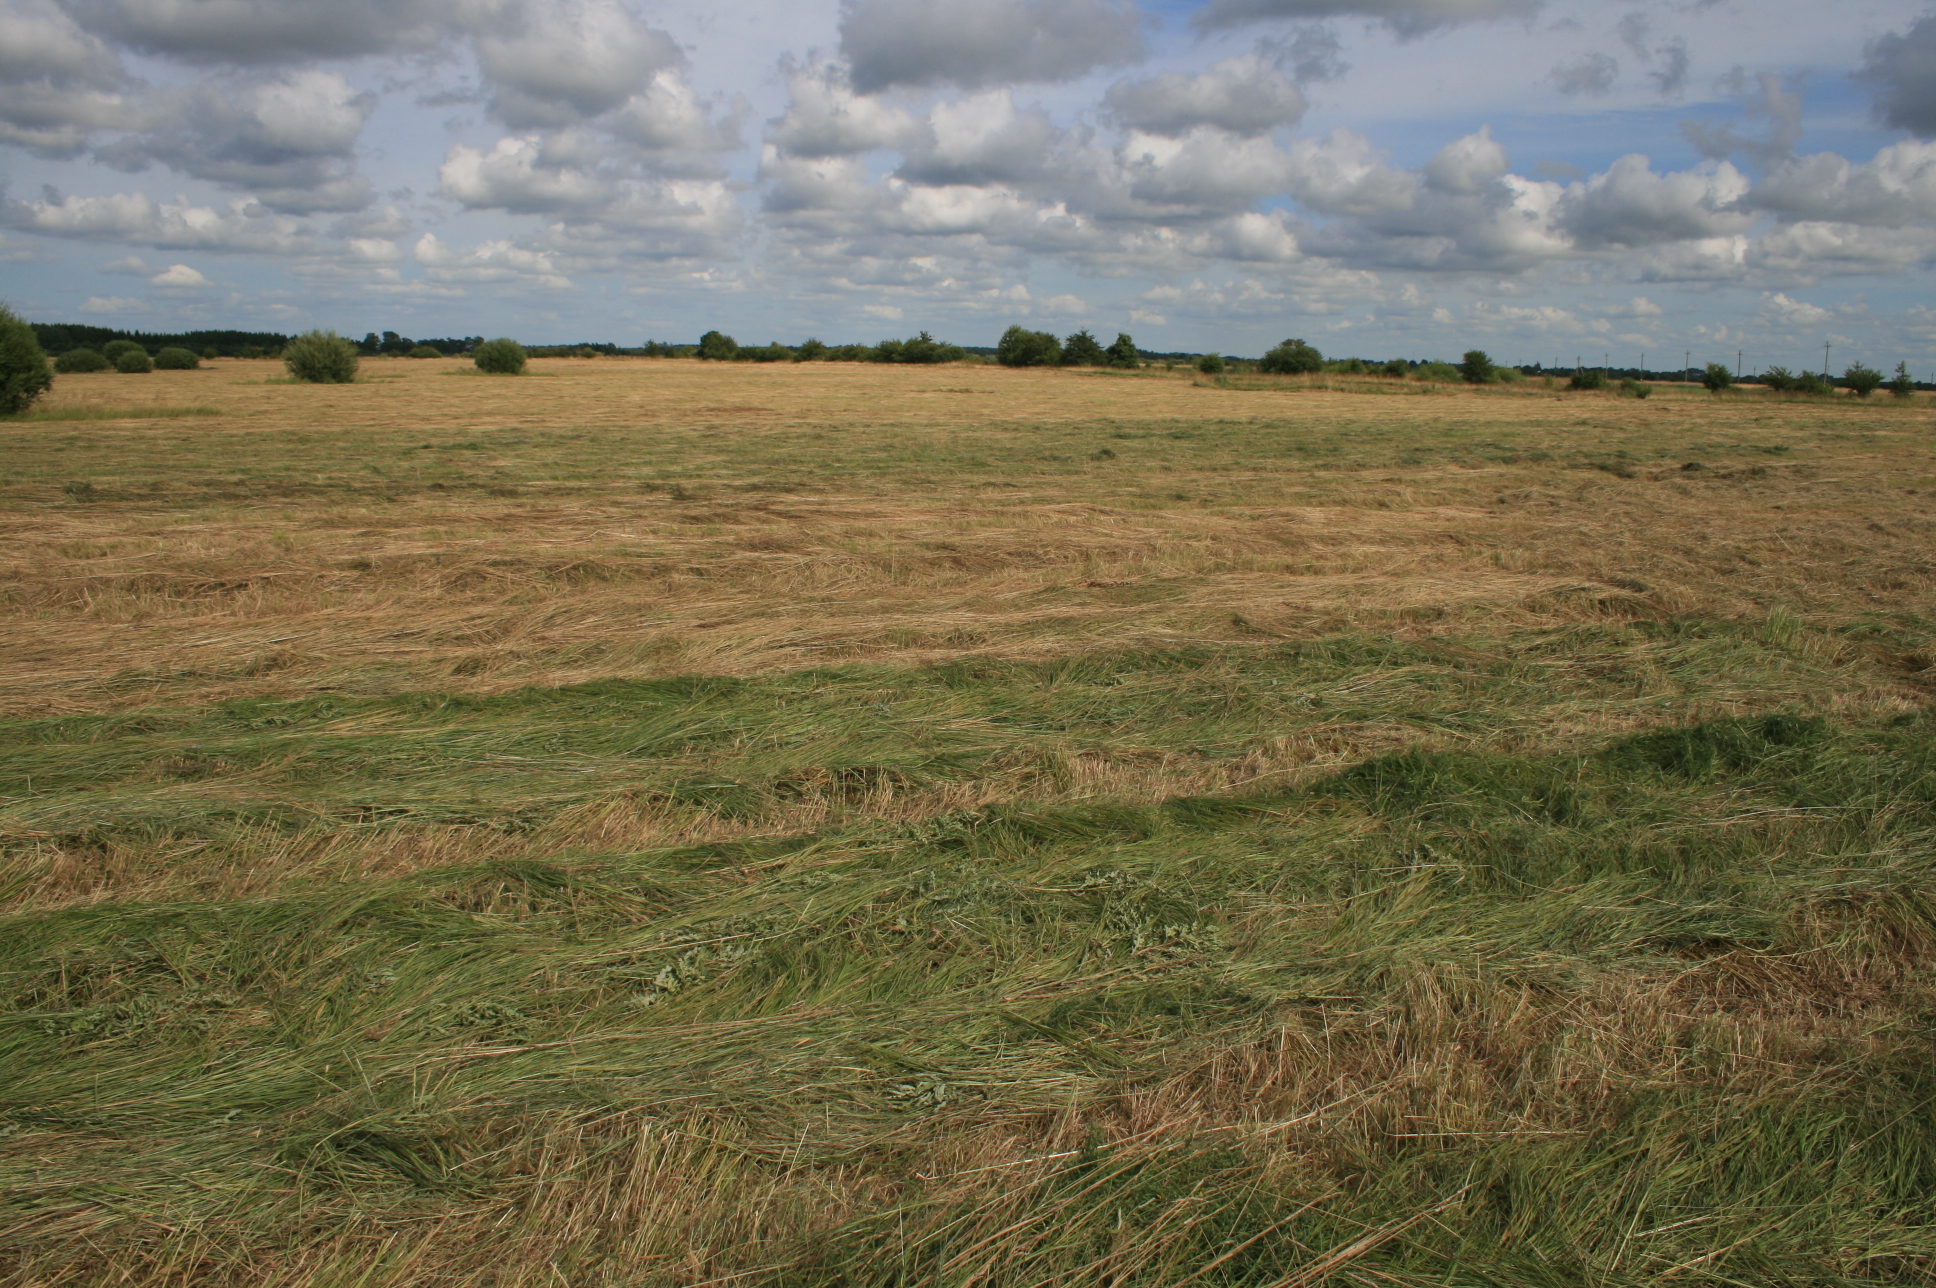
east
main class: Grassland
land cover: Grassland without tree/shrub cover
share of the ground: > 75 %
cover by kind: herbaceous plants 100 %
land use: Agriculture (excluding fallow land and kitchen gardens)
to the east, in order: Grassland without tree/shrub cover
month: July
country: LT
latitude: 55.5377
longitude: 21.3416
